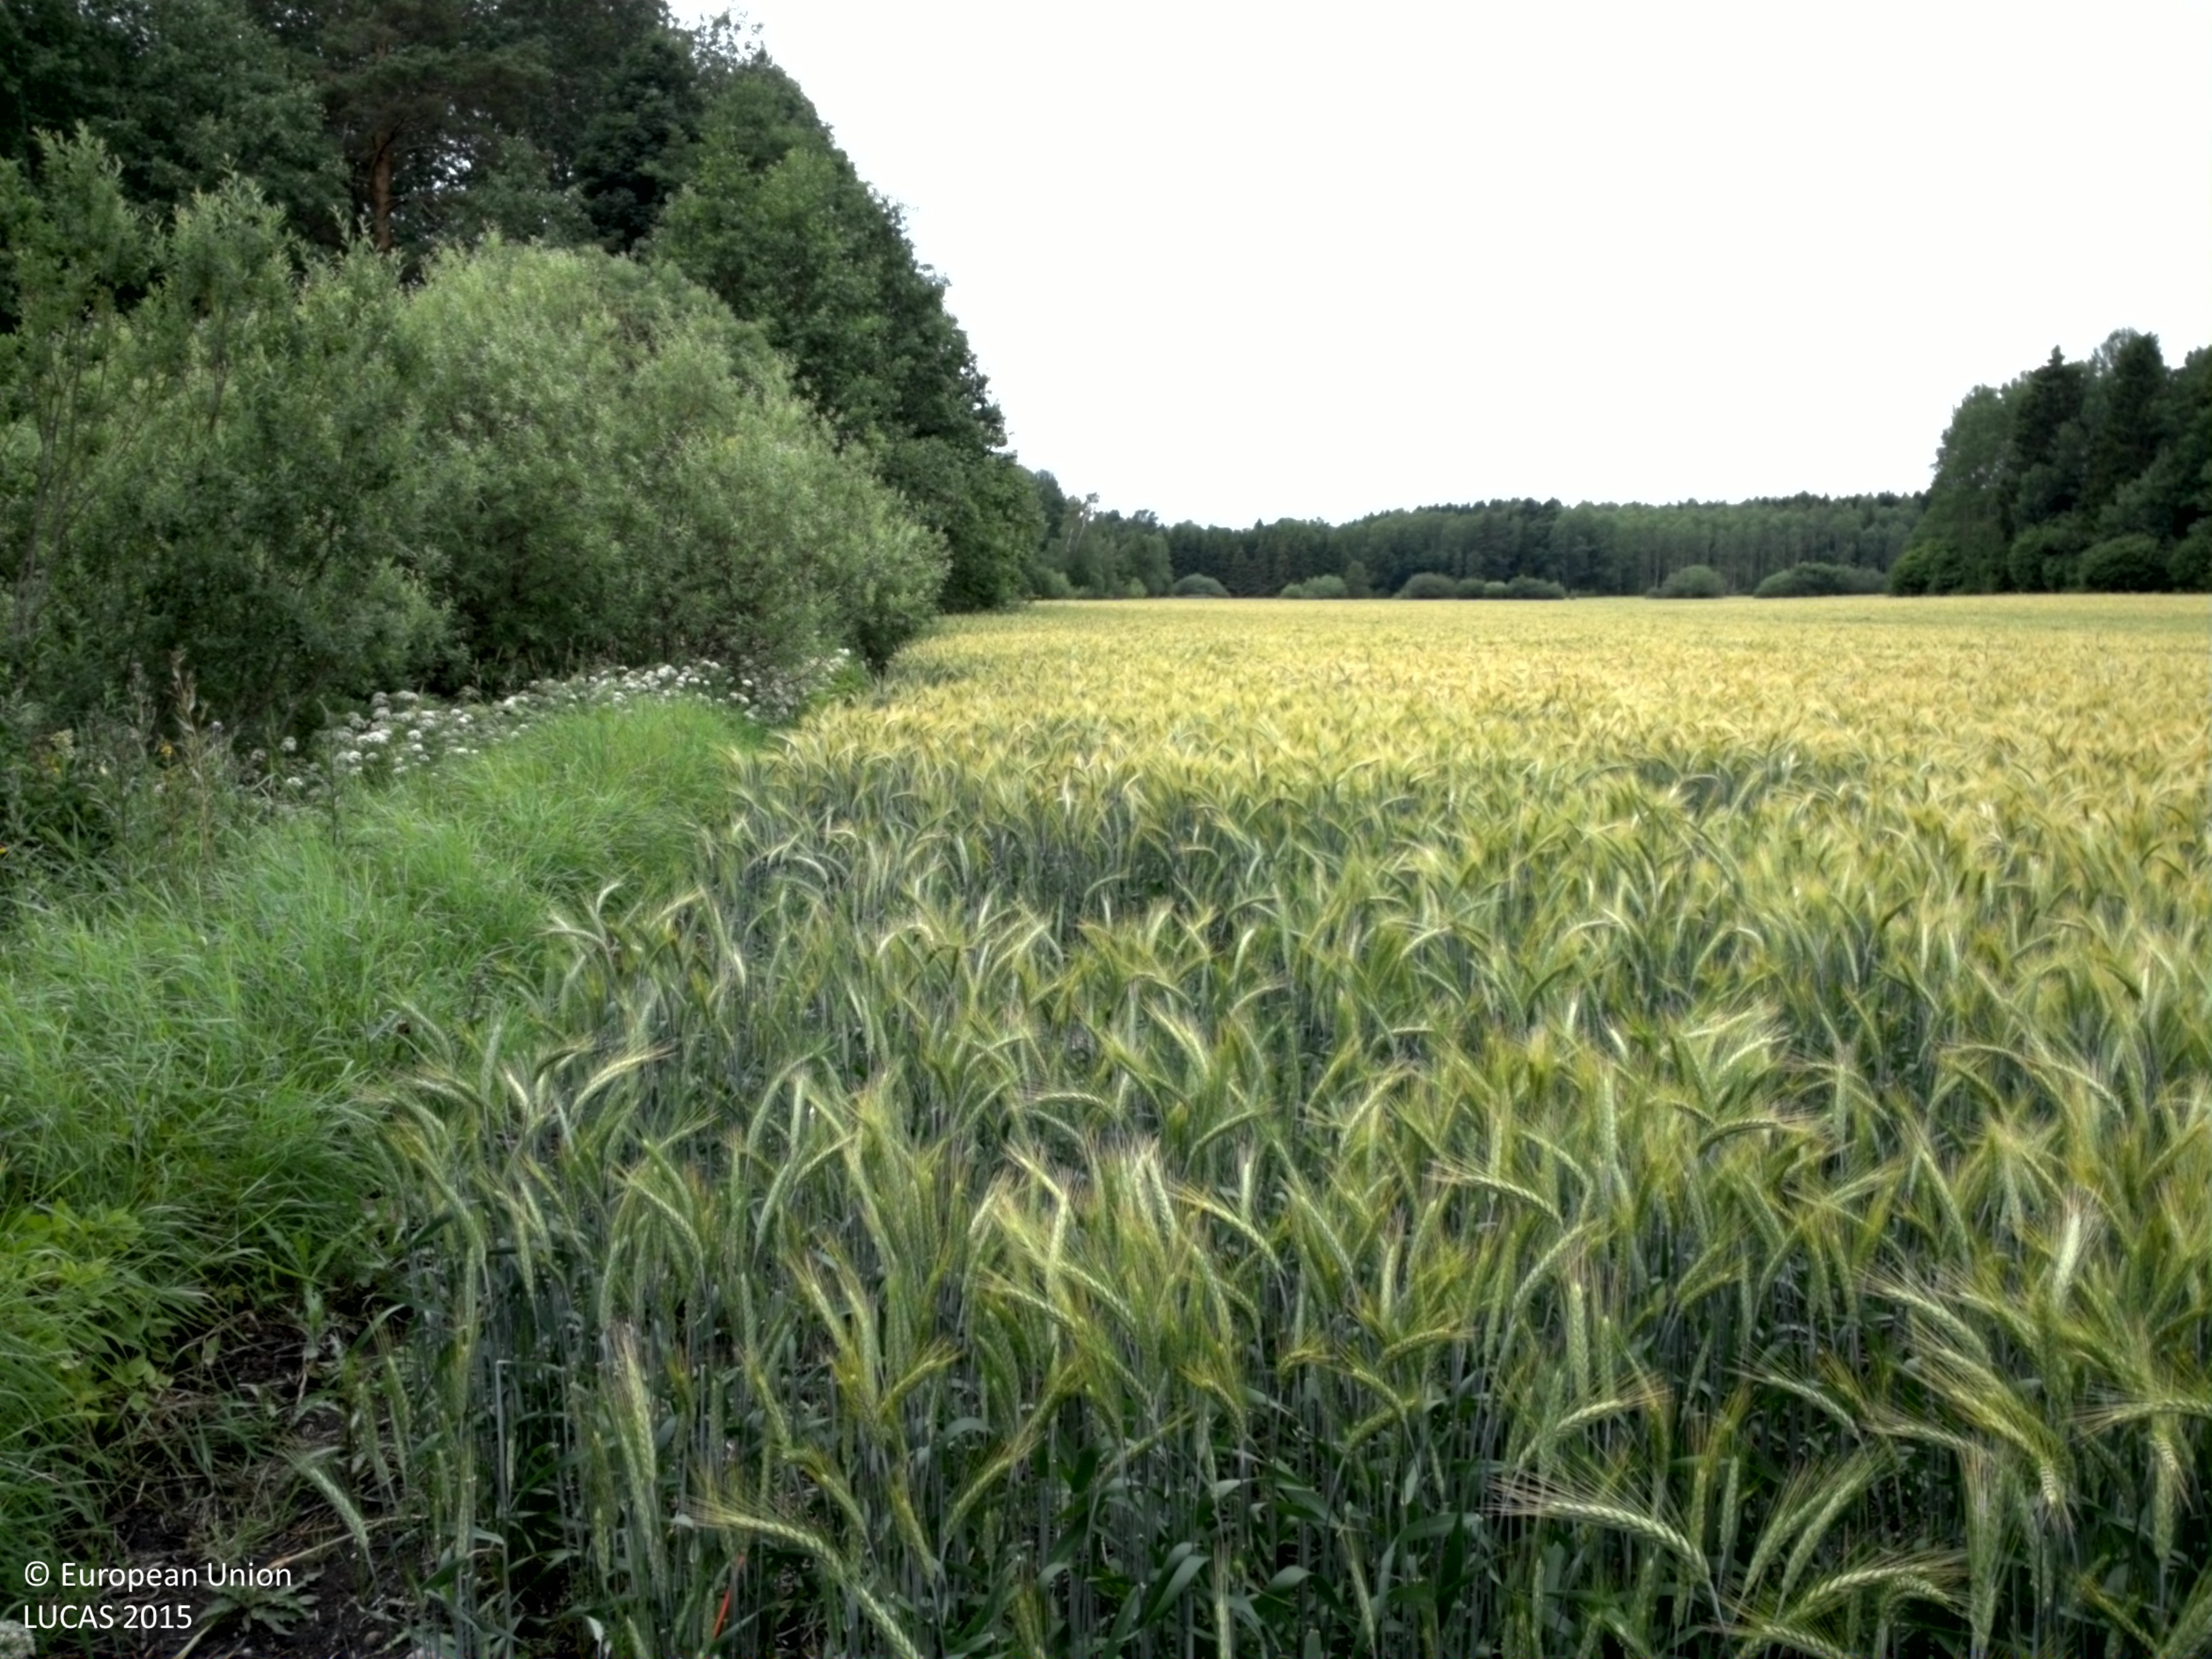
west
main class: Cropland
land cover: Rye
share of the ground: > 75 %
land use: Agriculture (excluding fallow land and kitchen gardens)
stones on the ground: < 10 %
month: July
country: SE
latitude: 59.7771
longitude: 18.5302
